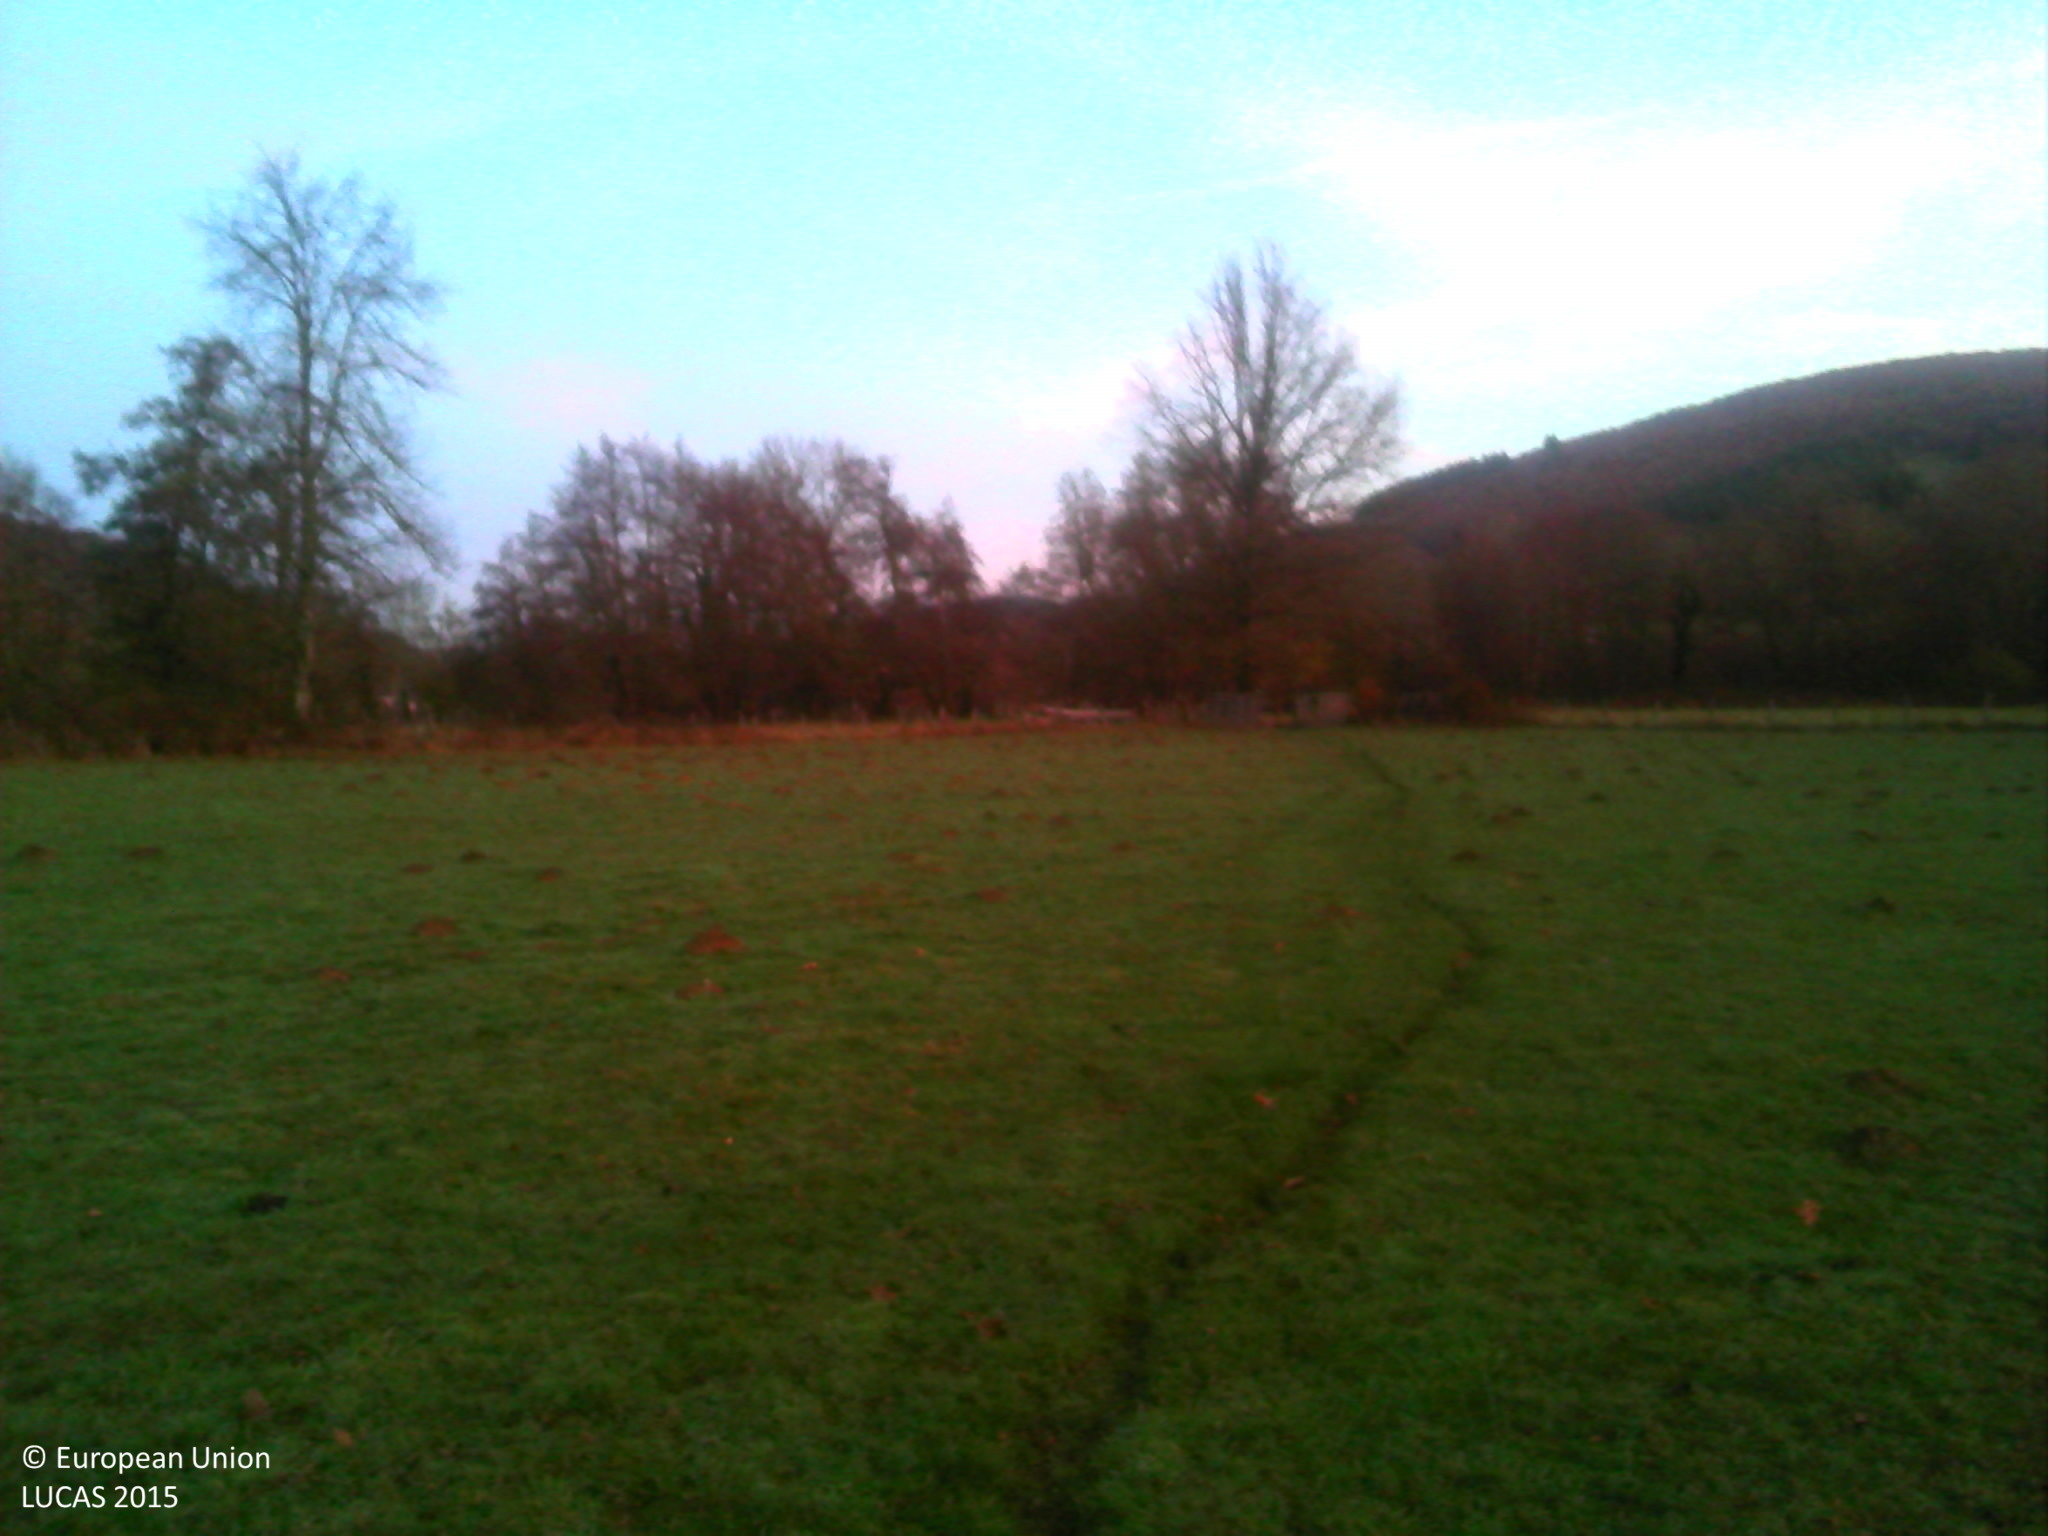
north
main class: Grassland
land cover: Grassland without tree/shrub cover
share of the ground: > 75 %
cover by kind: herbaceous plants 100 %
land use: Agriculture (excluding fallow land and kitchen gardens)
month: November
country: FR
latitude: 46.0574
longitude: 3.7058
